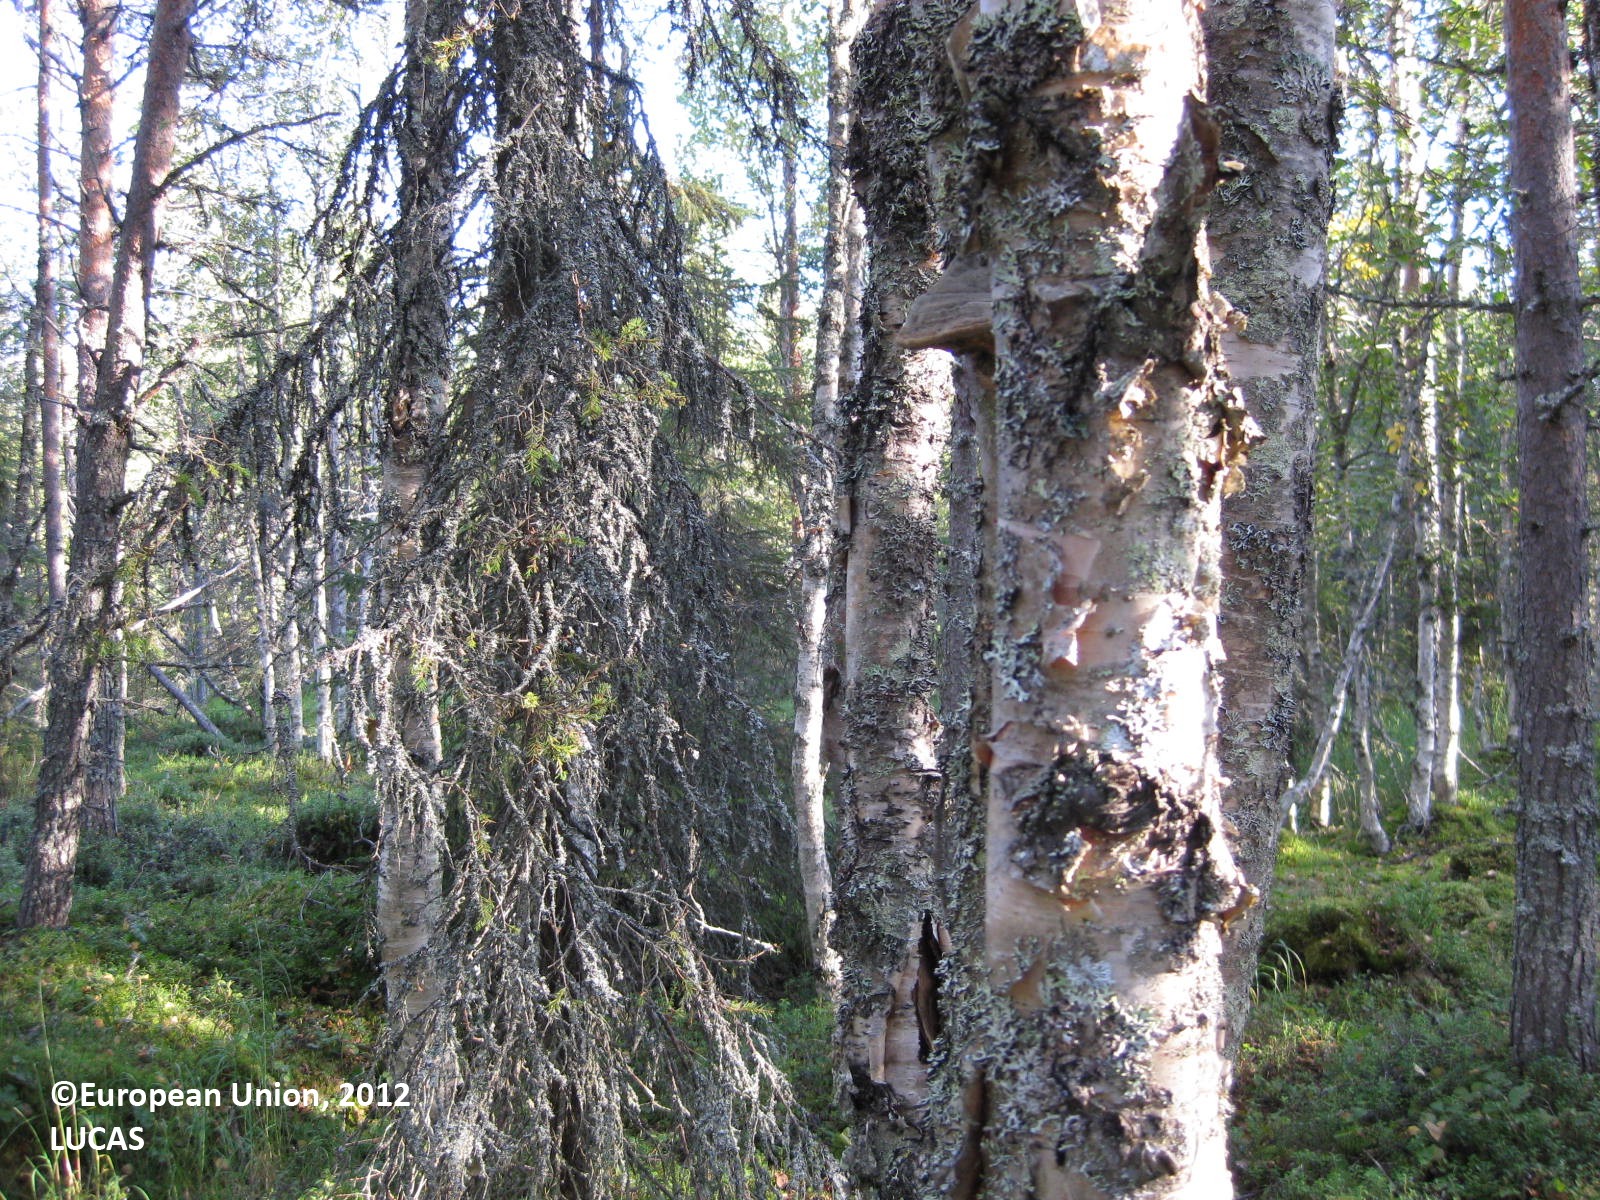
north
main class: Woodland
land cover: Other mixed woodland
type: boreal forest
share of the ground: > 75 %
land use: Forestry
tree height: > 5 m
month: August
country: FI
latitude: 66.0520
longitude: 29.5542
